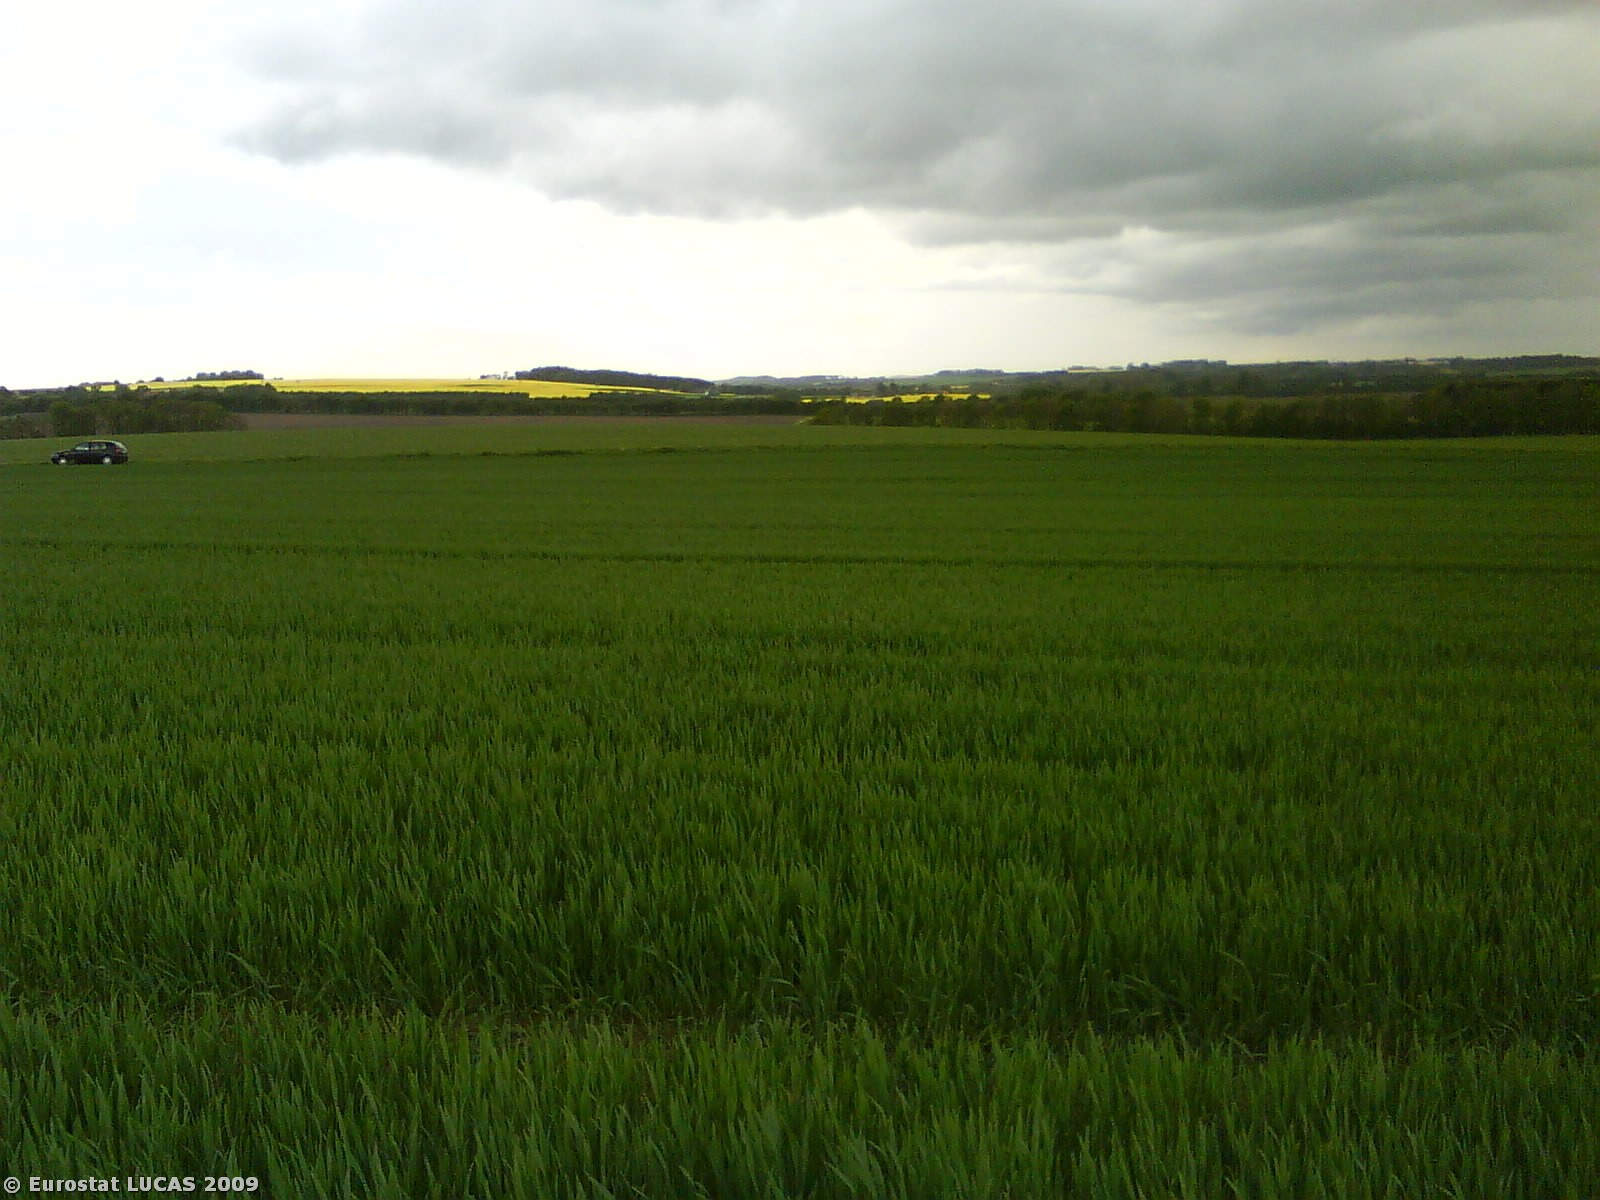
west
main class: Cropland
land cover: Common wheat
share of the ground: > 75 %
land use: Agriculture (excluding fallow land and kitchen gardens)
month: May
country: DK
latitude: 56.4031
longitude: 10.2751
